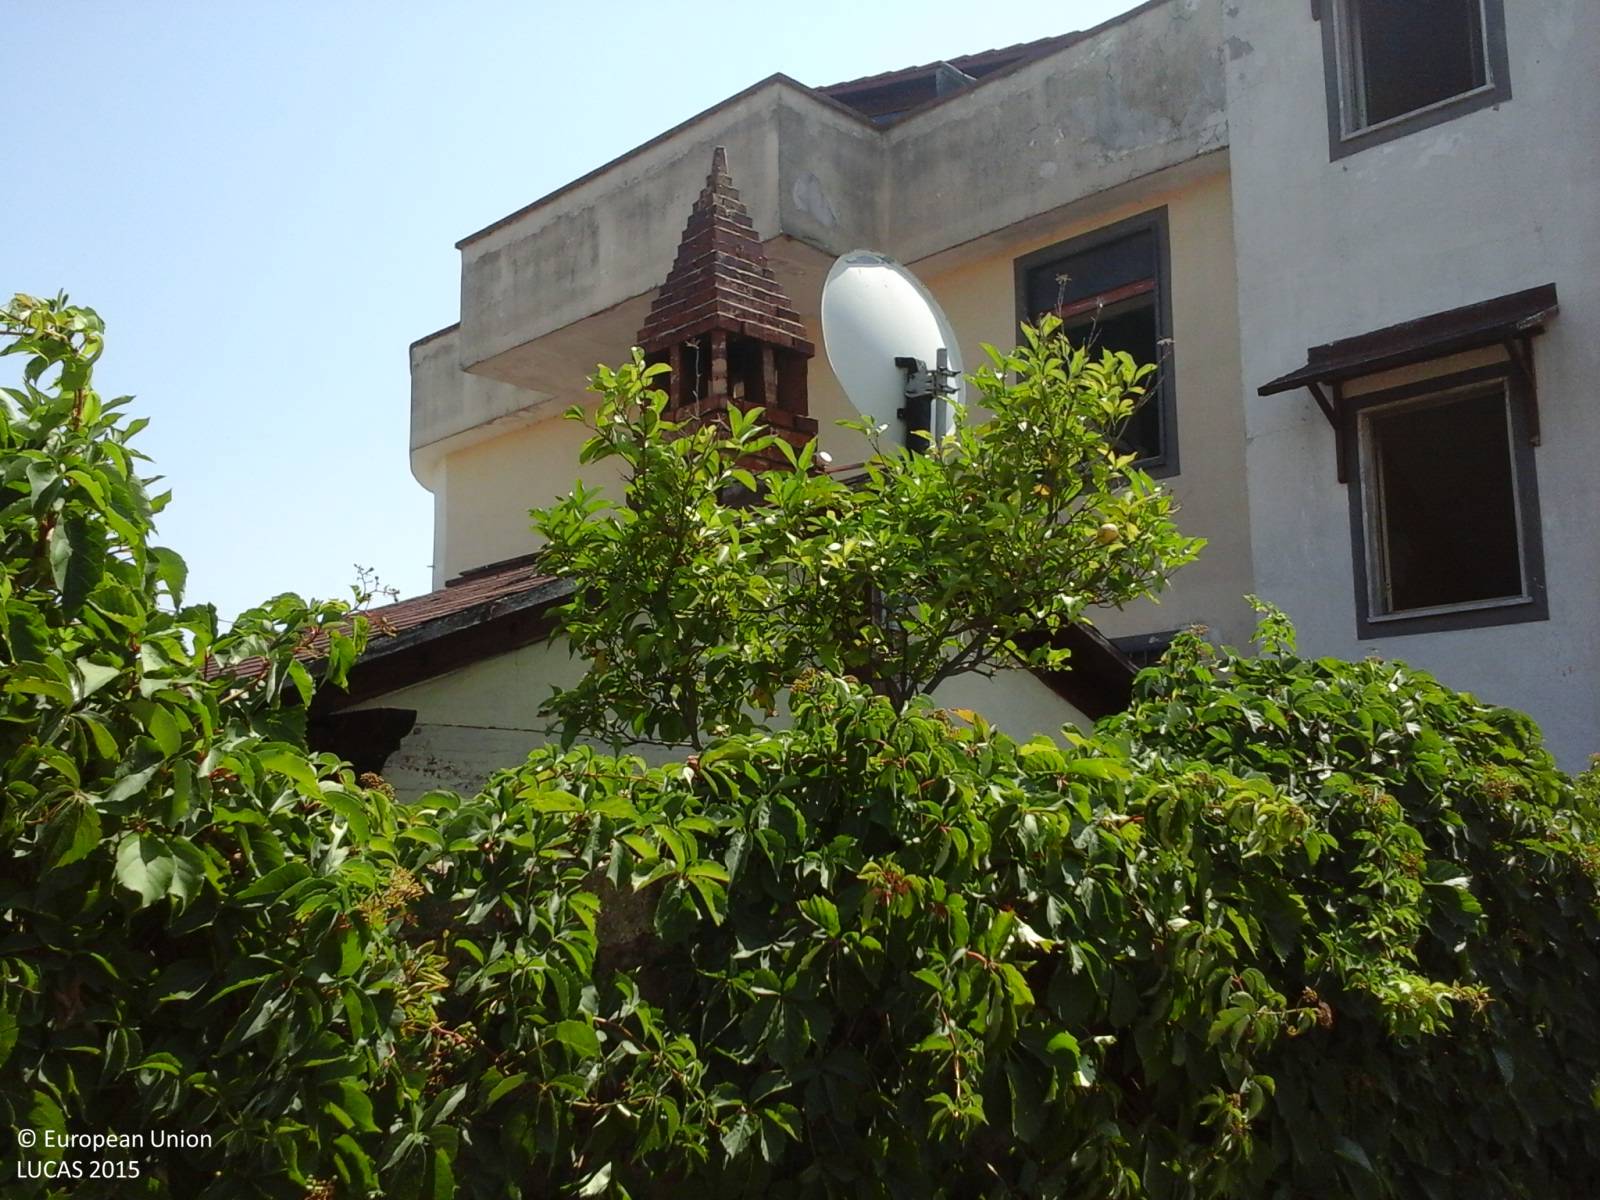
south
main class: Cropland
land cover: Oats
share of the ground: < 10 %
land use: Agriculture (excluding fallow land and kitchen gardens)
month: July
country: IT
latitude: 40.9832
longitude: 13.9889
